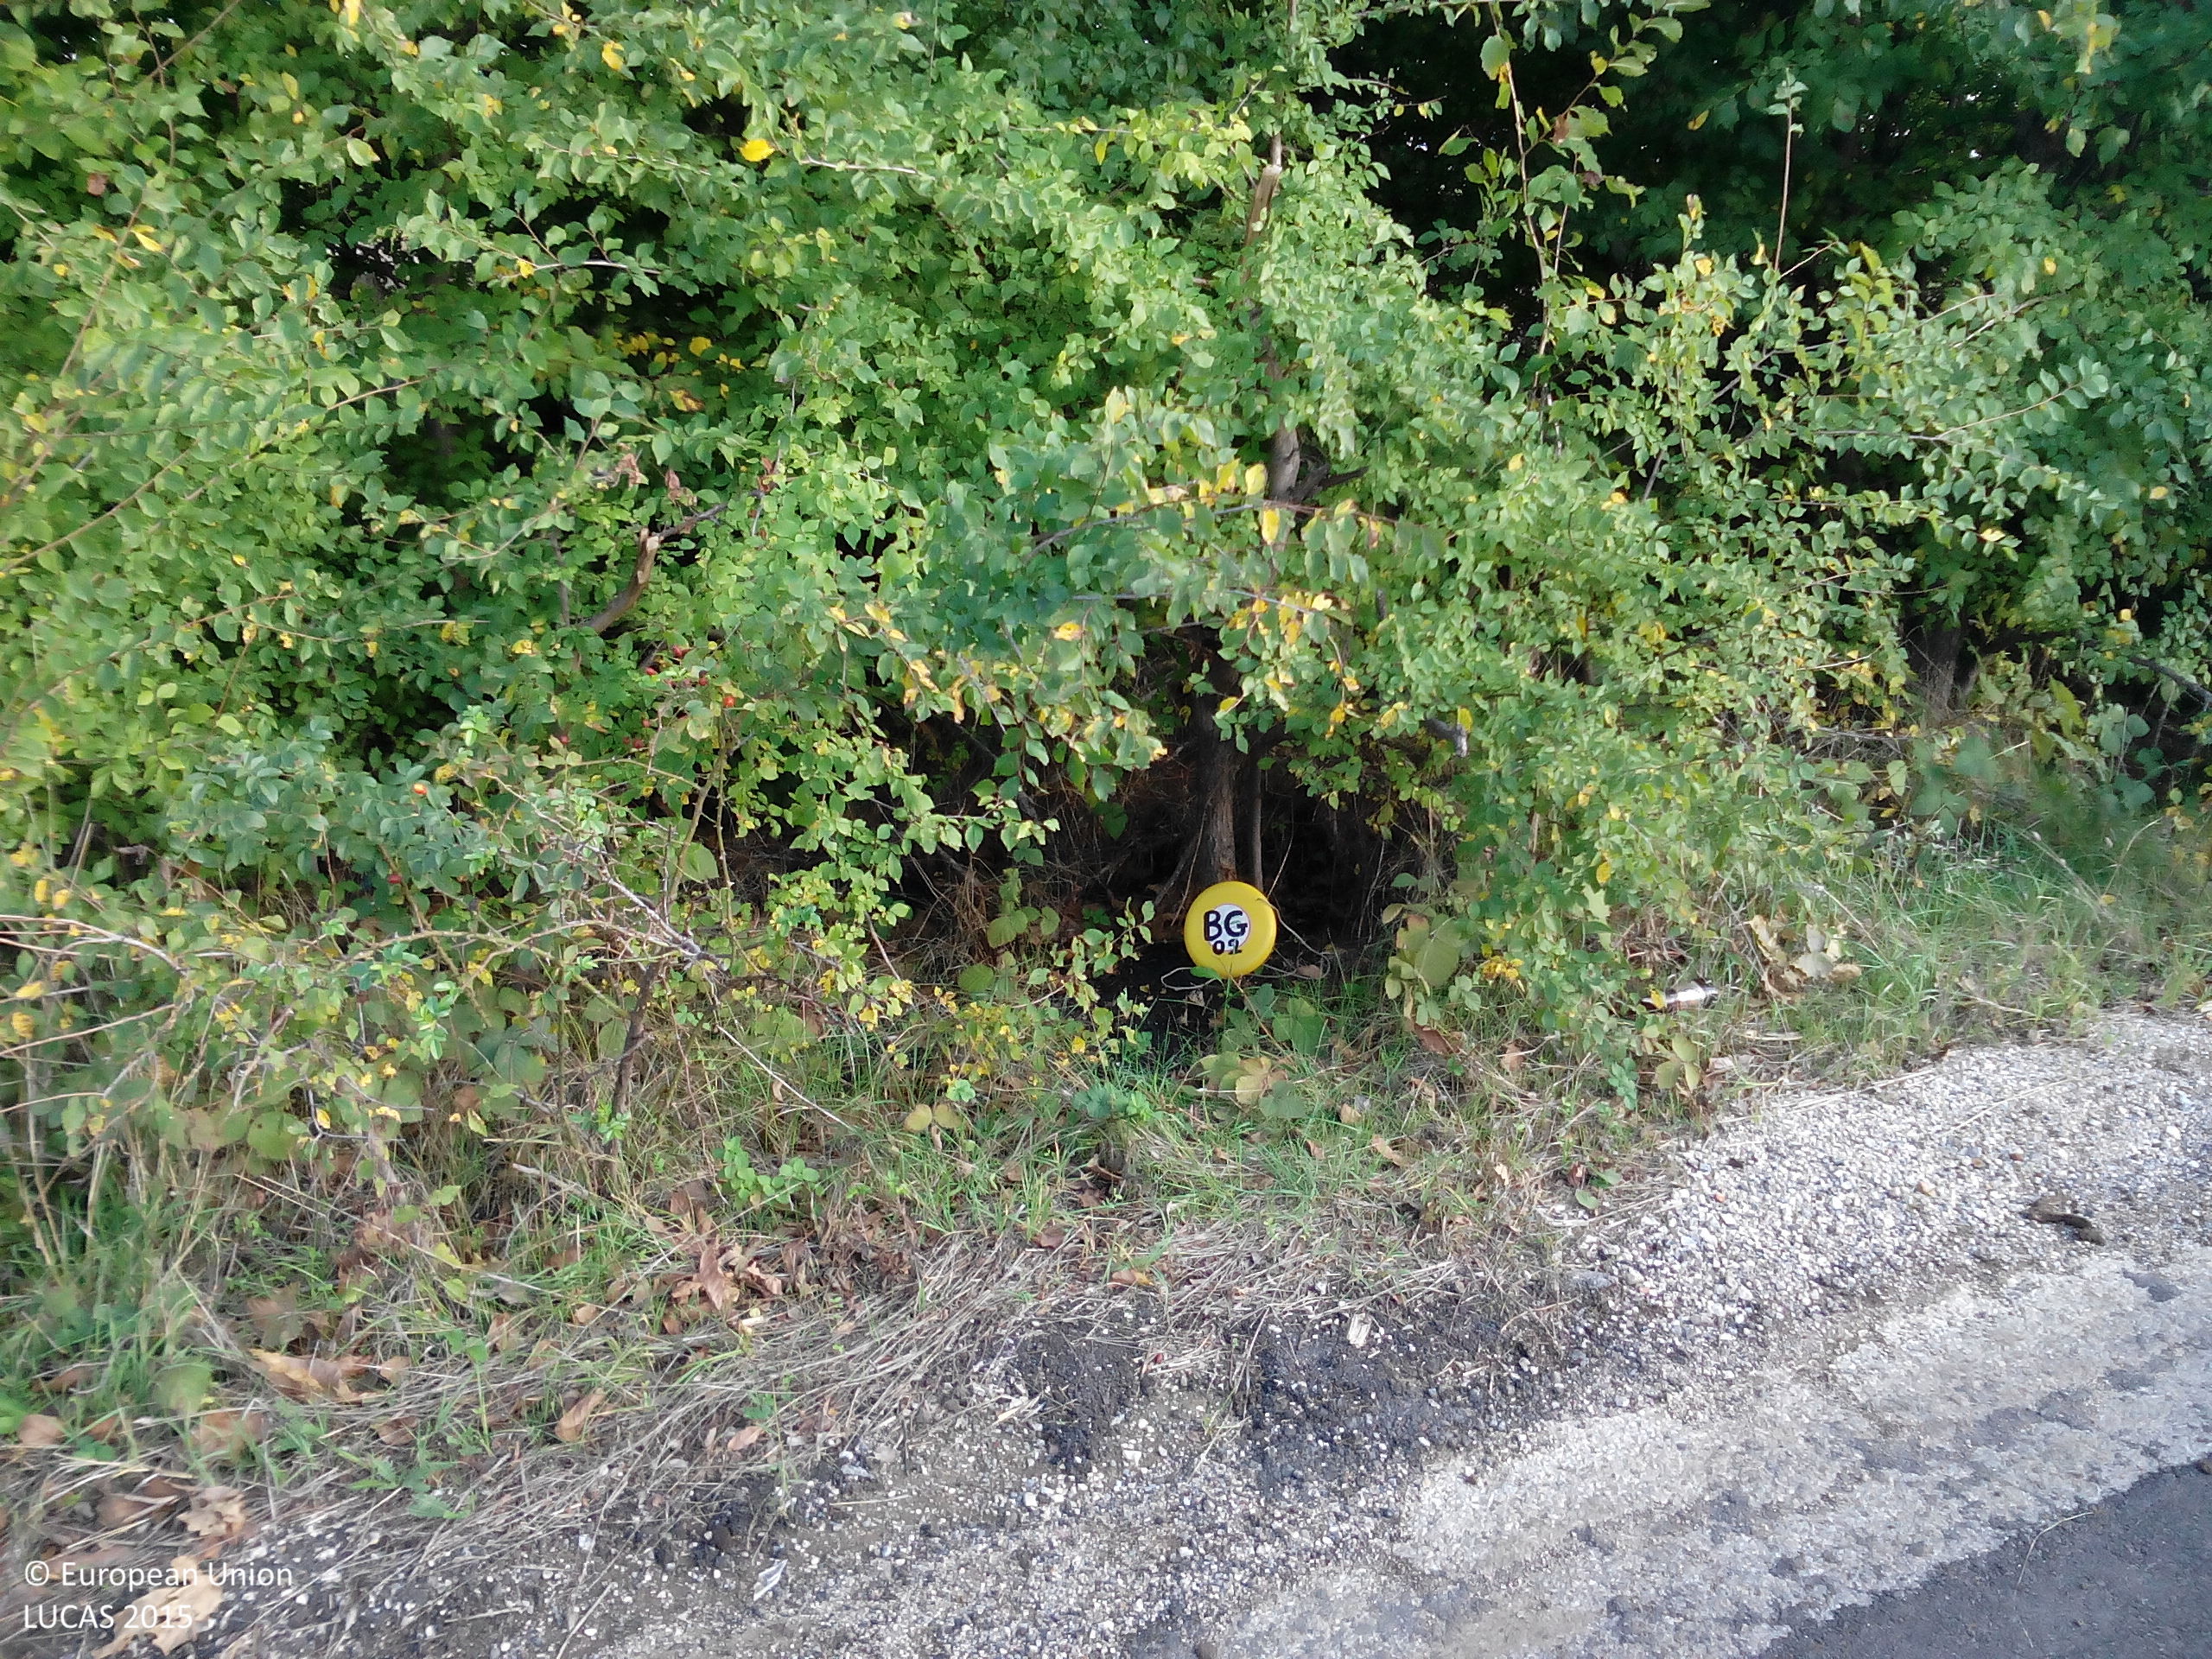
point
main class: Woodland
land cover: Broadleaved woodland
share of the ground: > 75 %
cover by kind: broadleaved forest trees 80 %, shrubs 20 %
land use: Road transport
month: October
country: BG
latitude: 43.2801
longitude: 23.9124
